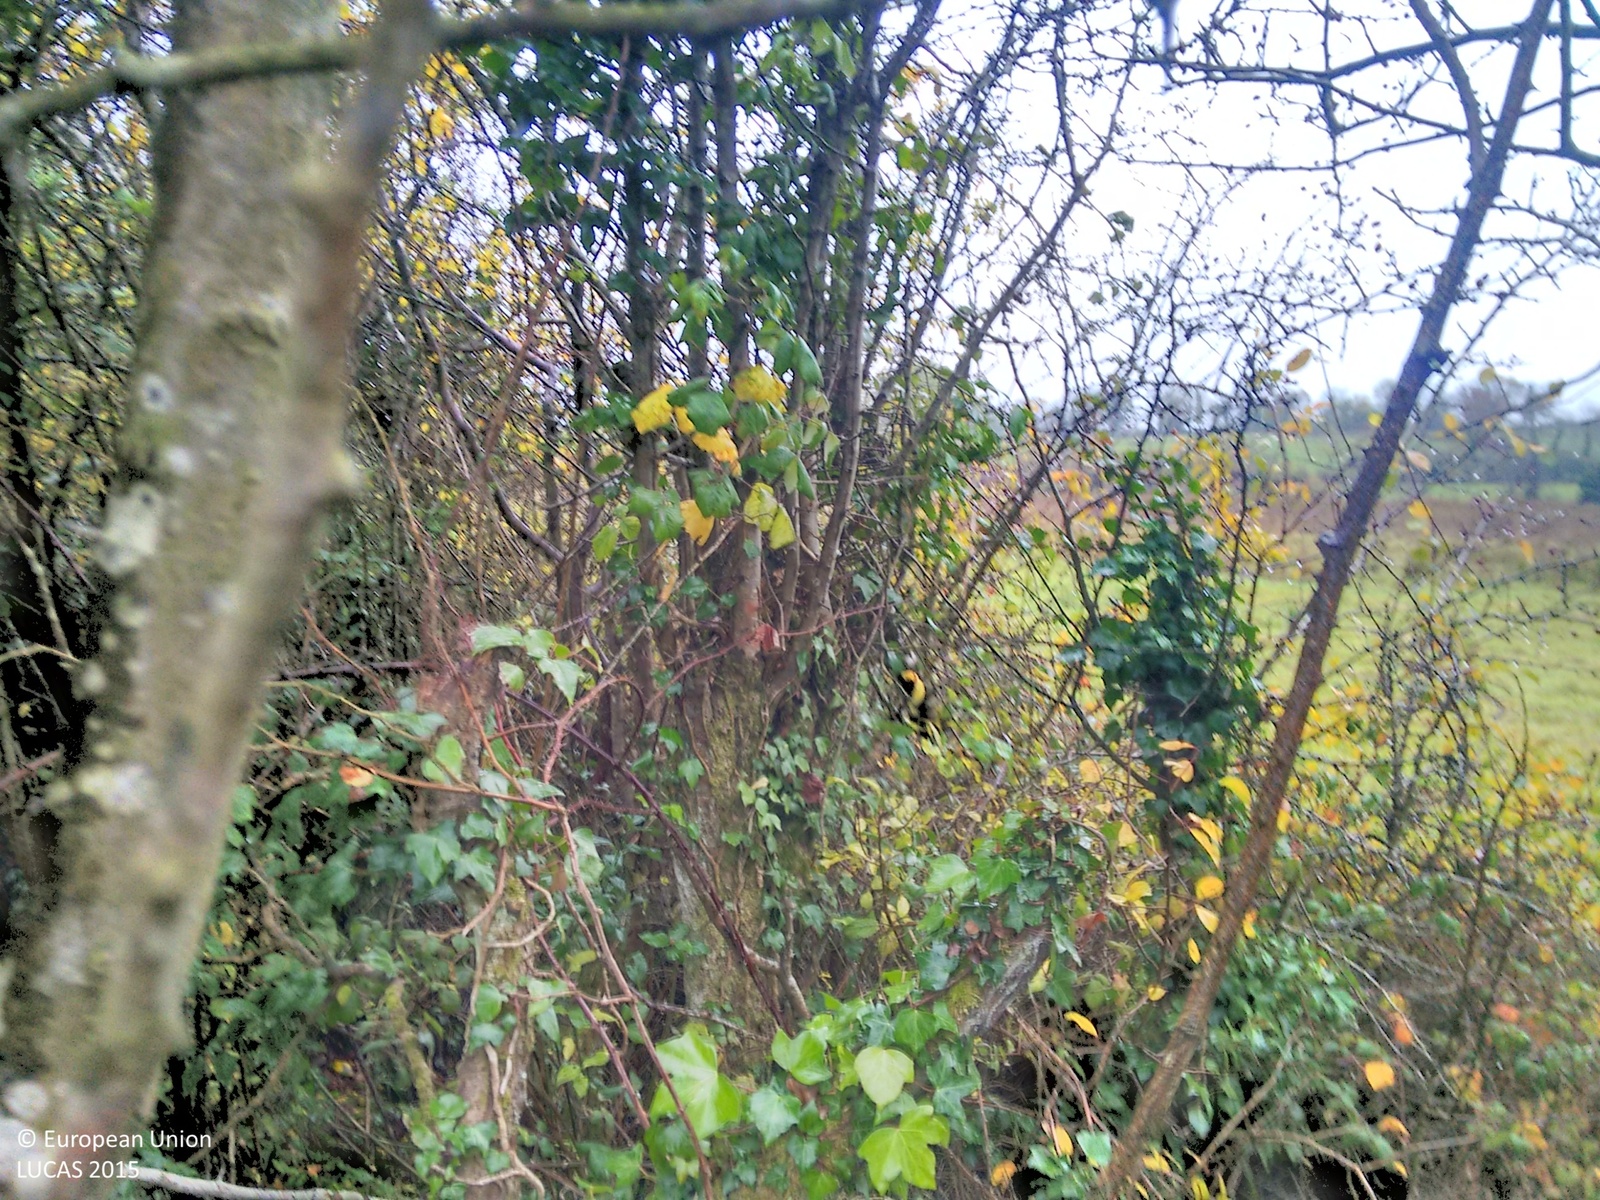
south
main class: Grassland
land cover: Grassland without tree/shrub cover
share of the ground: > 75 %
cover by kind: herbaceous plants 100 %
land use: Agriculture (excluding fallow land and kitchen gardens)
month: October
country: IE
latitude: 53.8833
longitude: -8.1148
